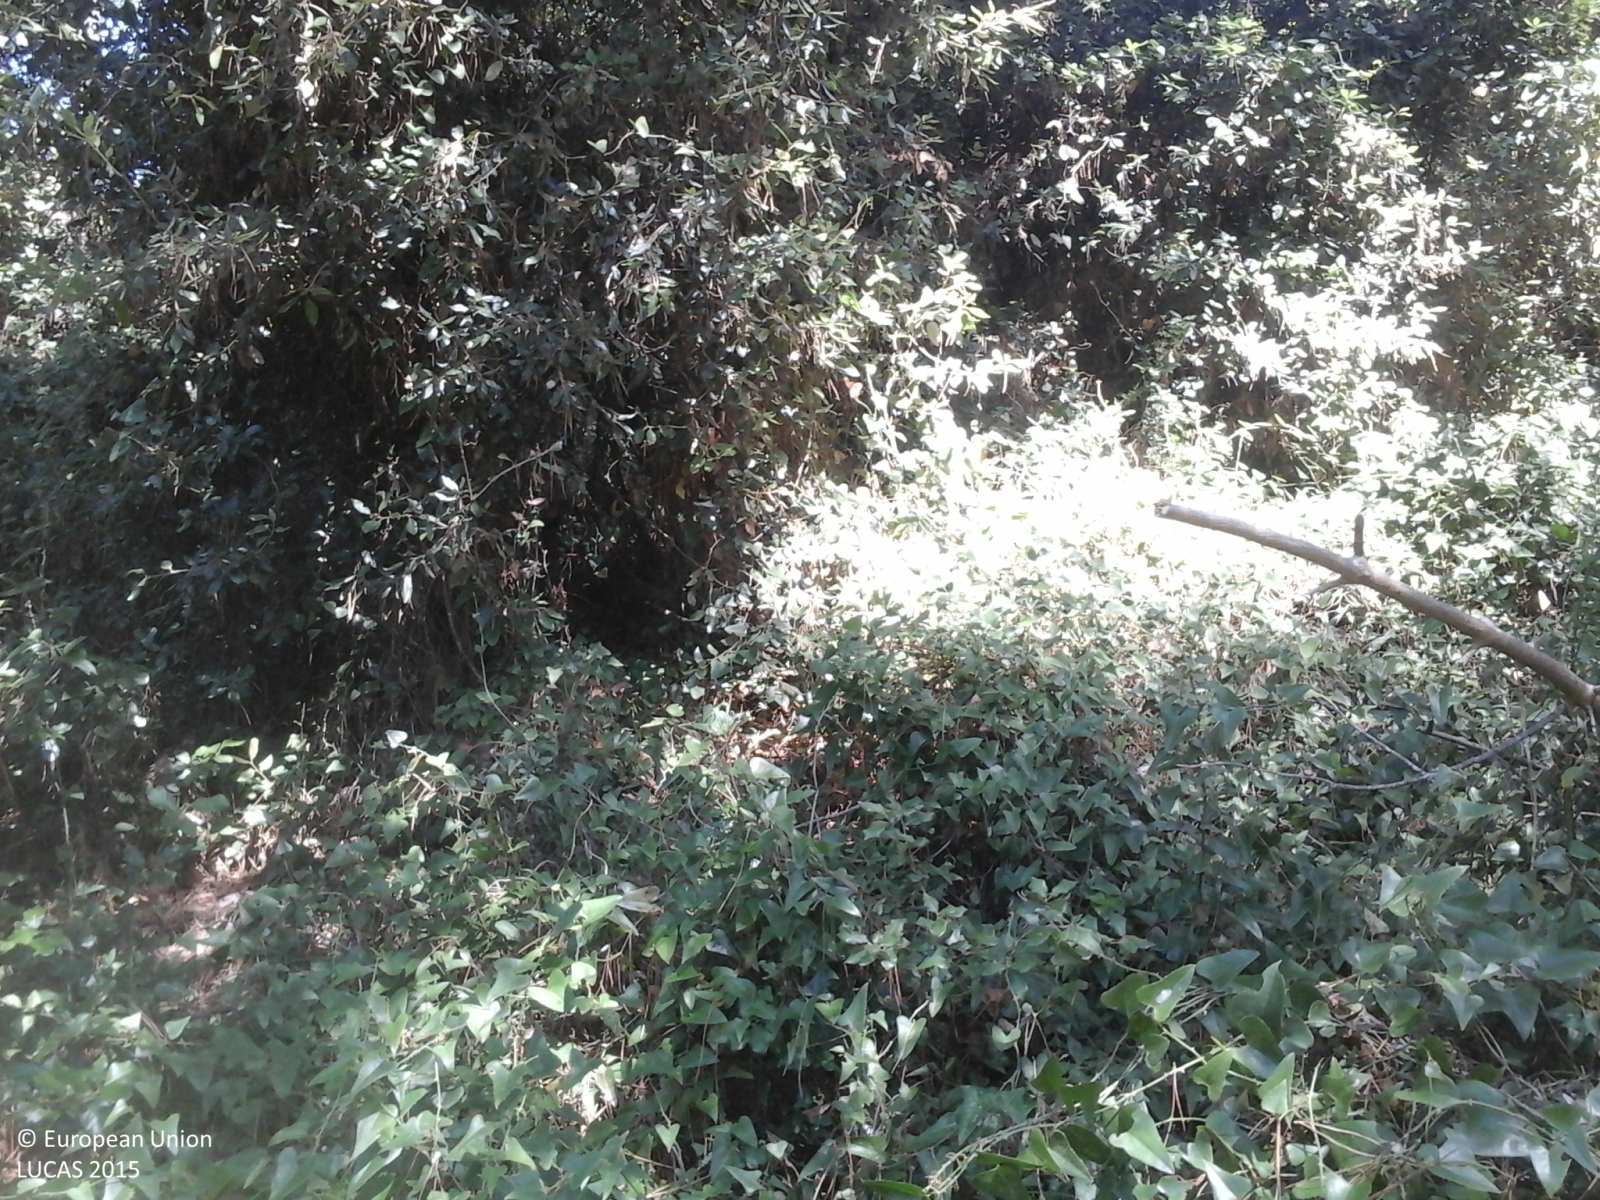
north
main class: Woodland
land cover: Pine dominated coniferous woodland
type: coniferous forest of the mediterranean region
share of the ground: > 75 %
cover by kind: coniferous forest trees 100 %
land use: Forestry
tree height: > 5 m
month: August
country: IT
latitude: 43.6646
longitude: 10.2844
